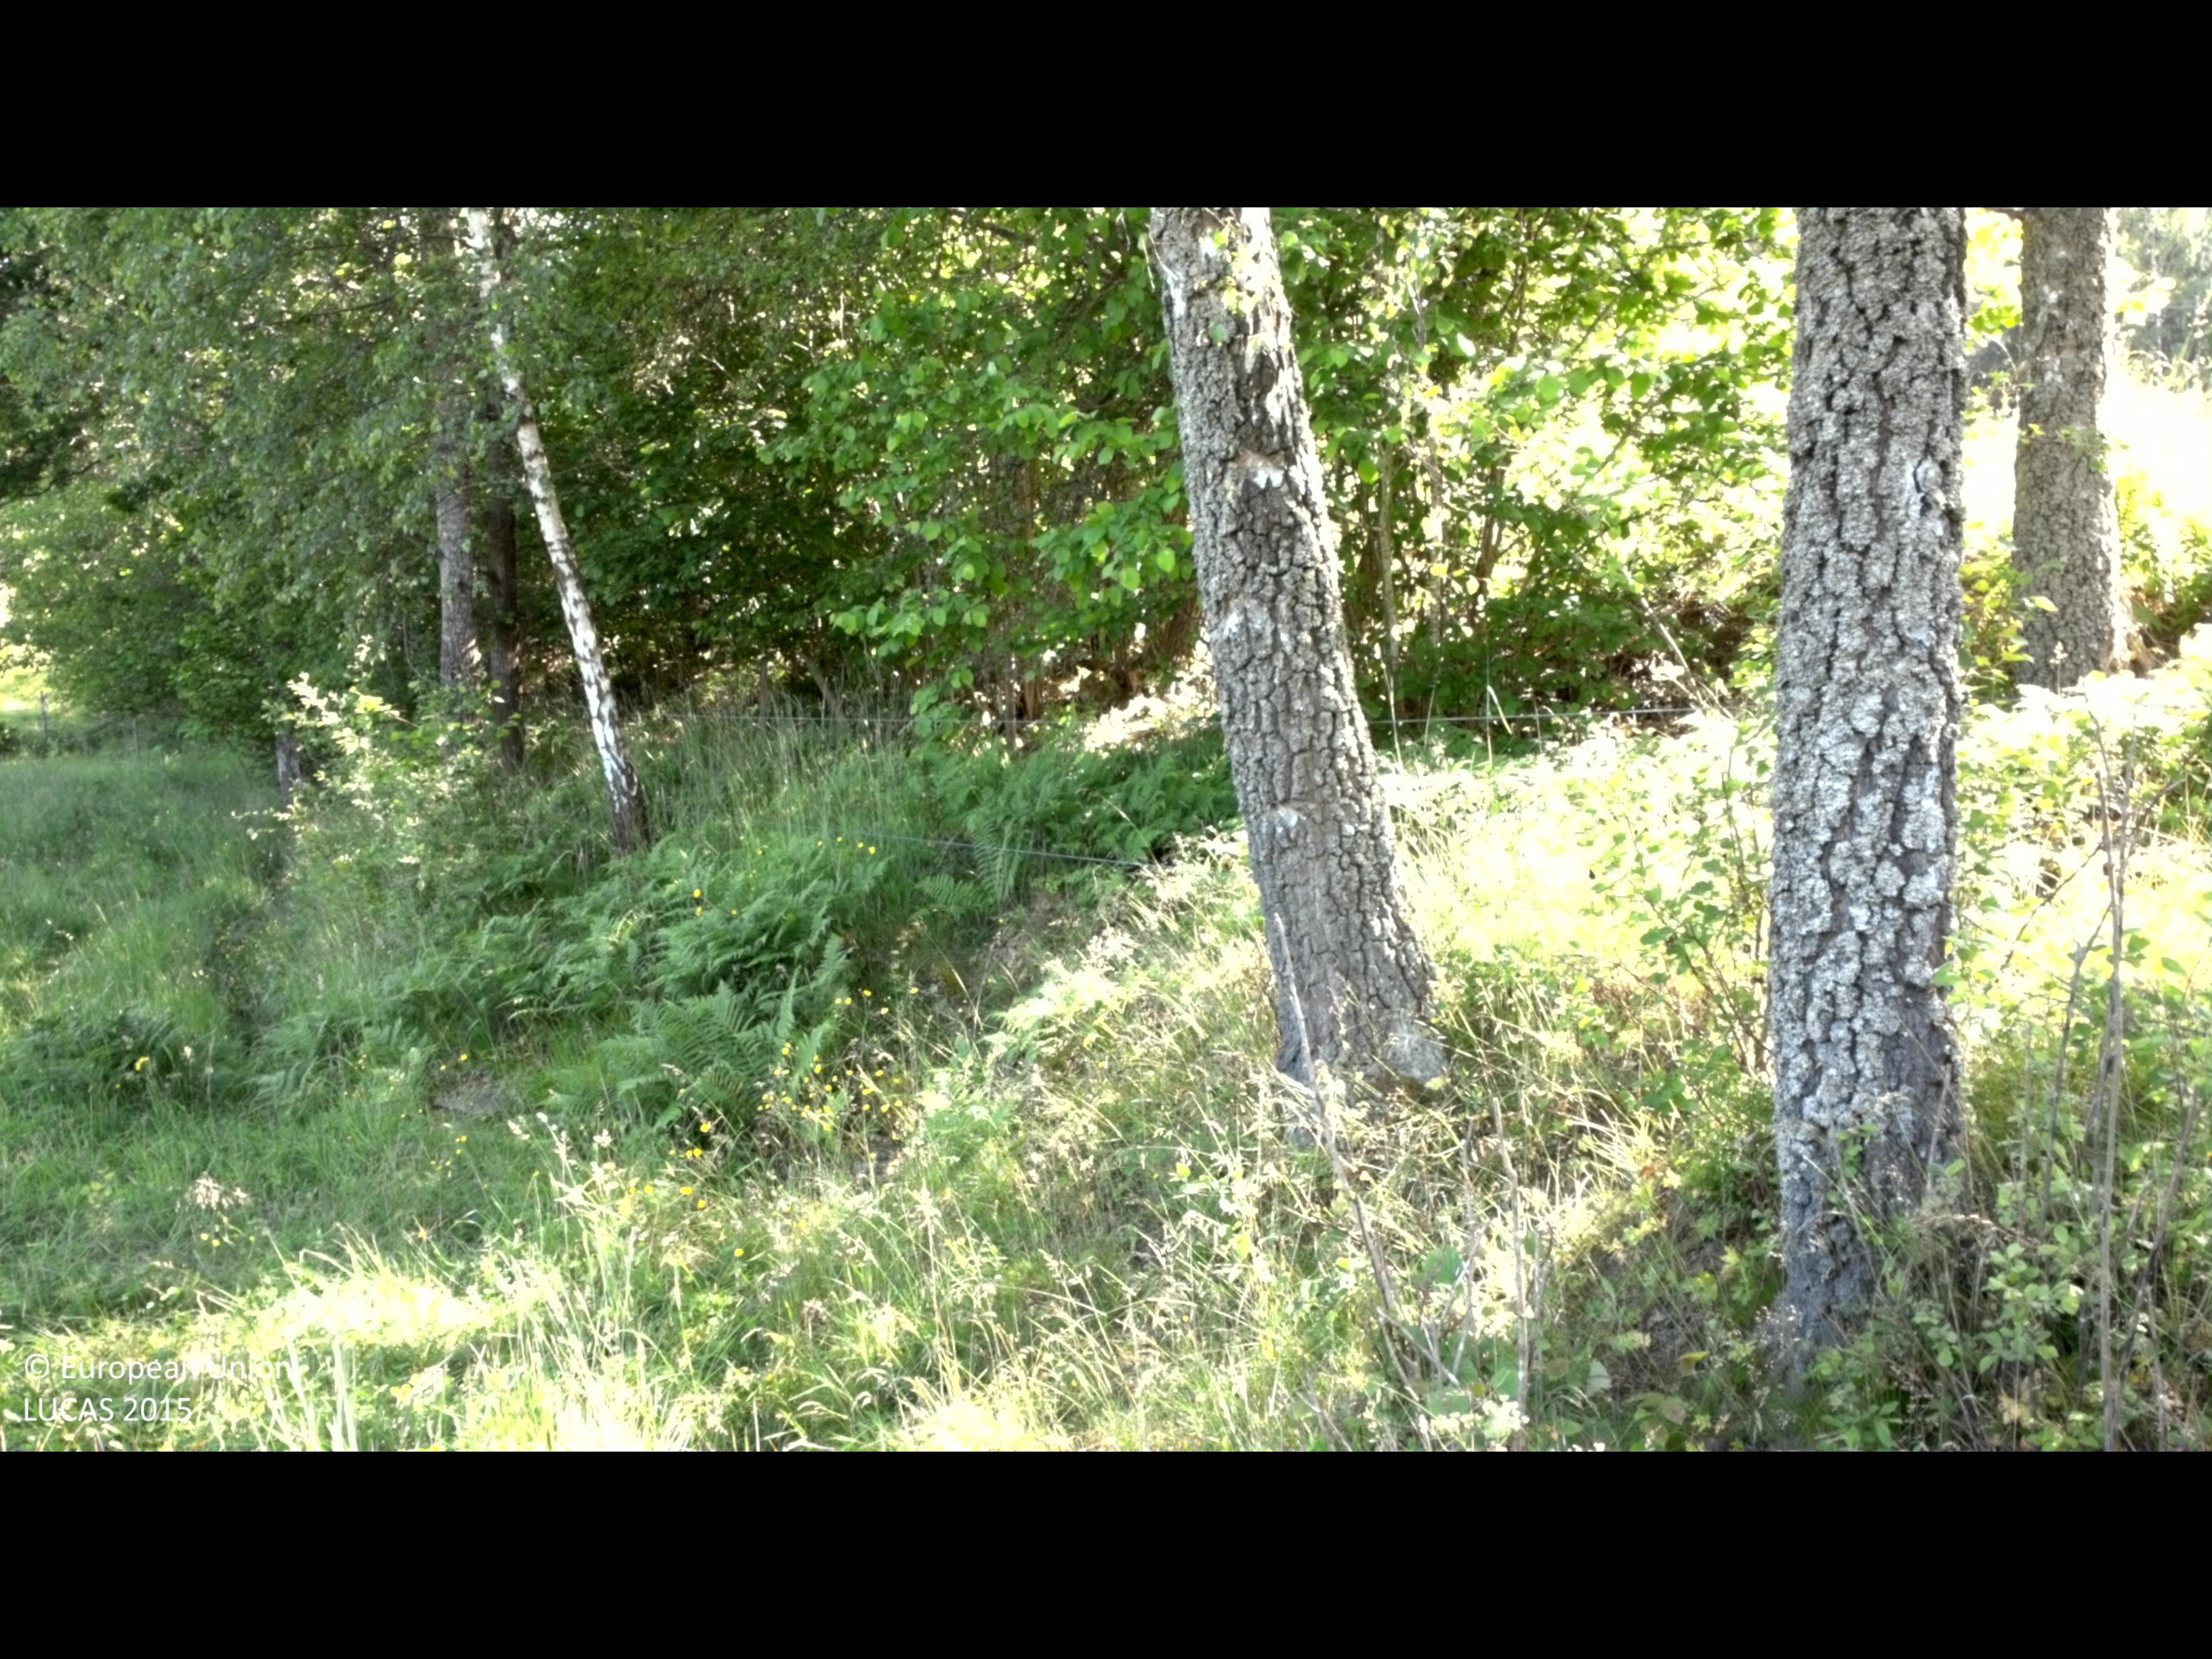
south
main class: Grassland
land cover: Grassland without tree/shrub cover
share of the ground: > 75 %
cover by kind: herbaceous plants 95 %, shrubs 5 %
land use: Agriculture (excluding fallow land and kitchen gardens)
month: June
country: SE
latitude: 58.2040
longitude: 16.1731
